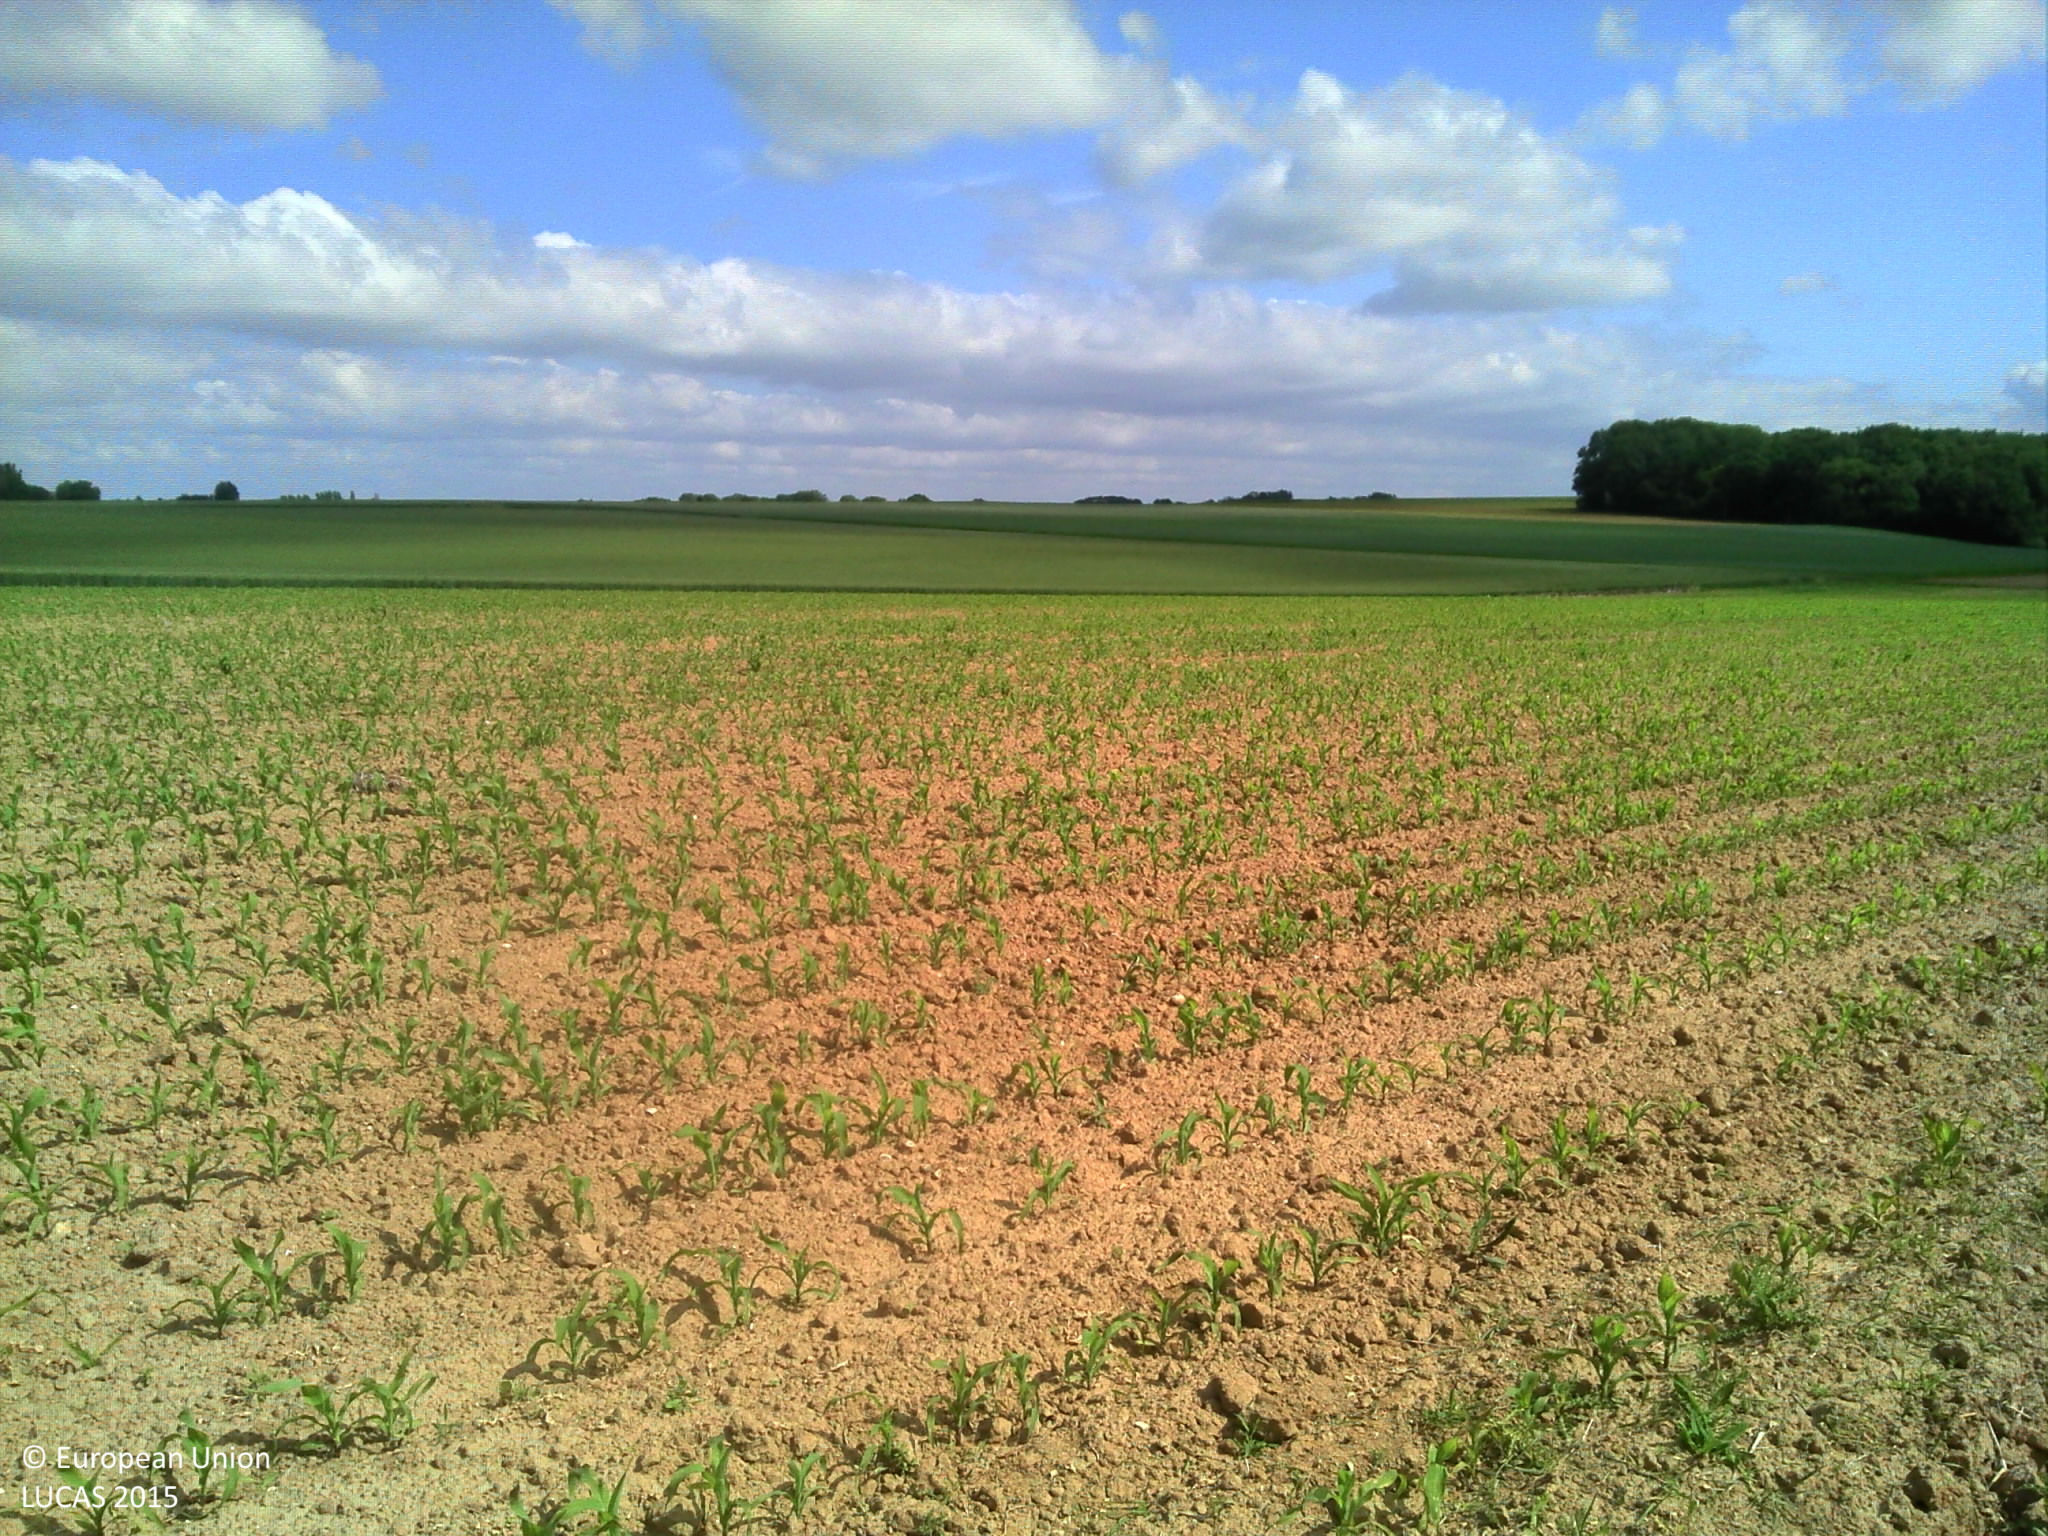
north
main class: Cropland
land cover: Common wheat
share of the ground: > 75 %
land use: Agriculture (excluding fallow land and kitchen gardens)
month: June
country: FR
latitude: 50.1073
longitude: 1.5782
